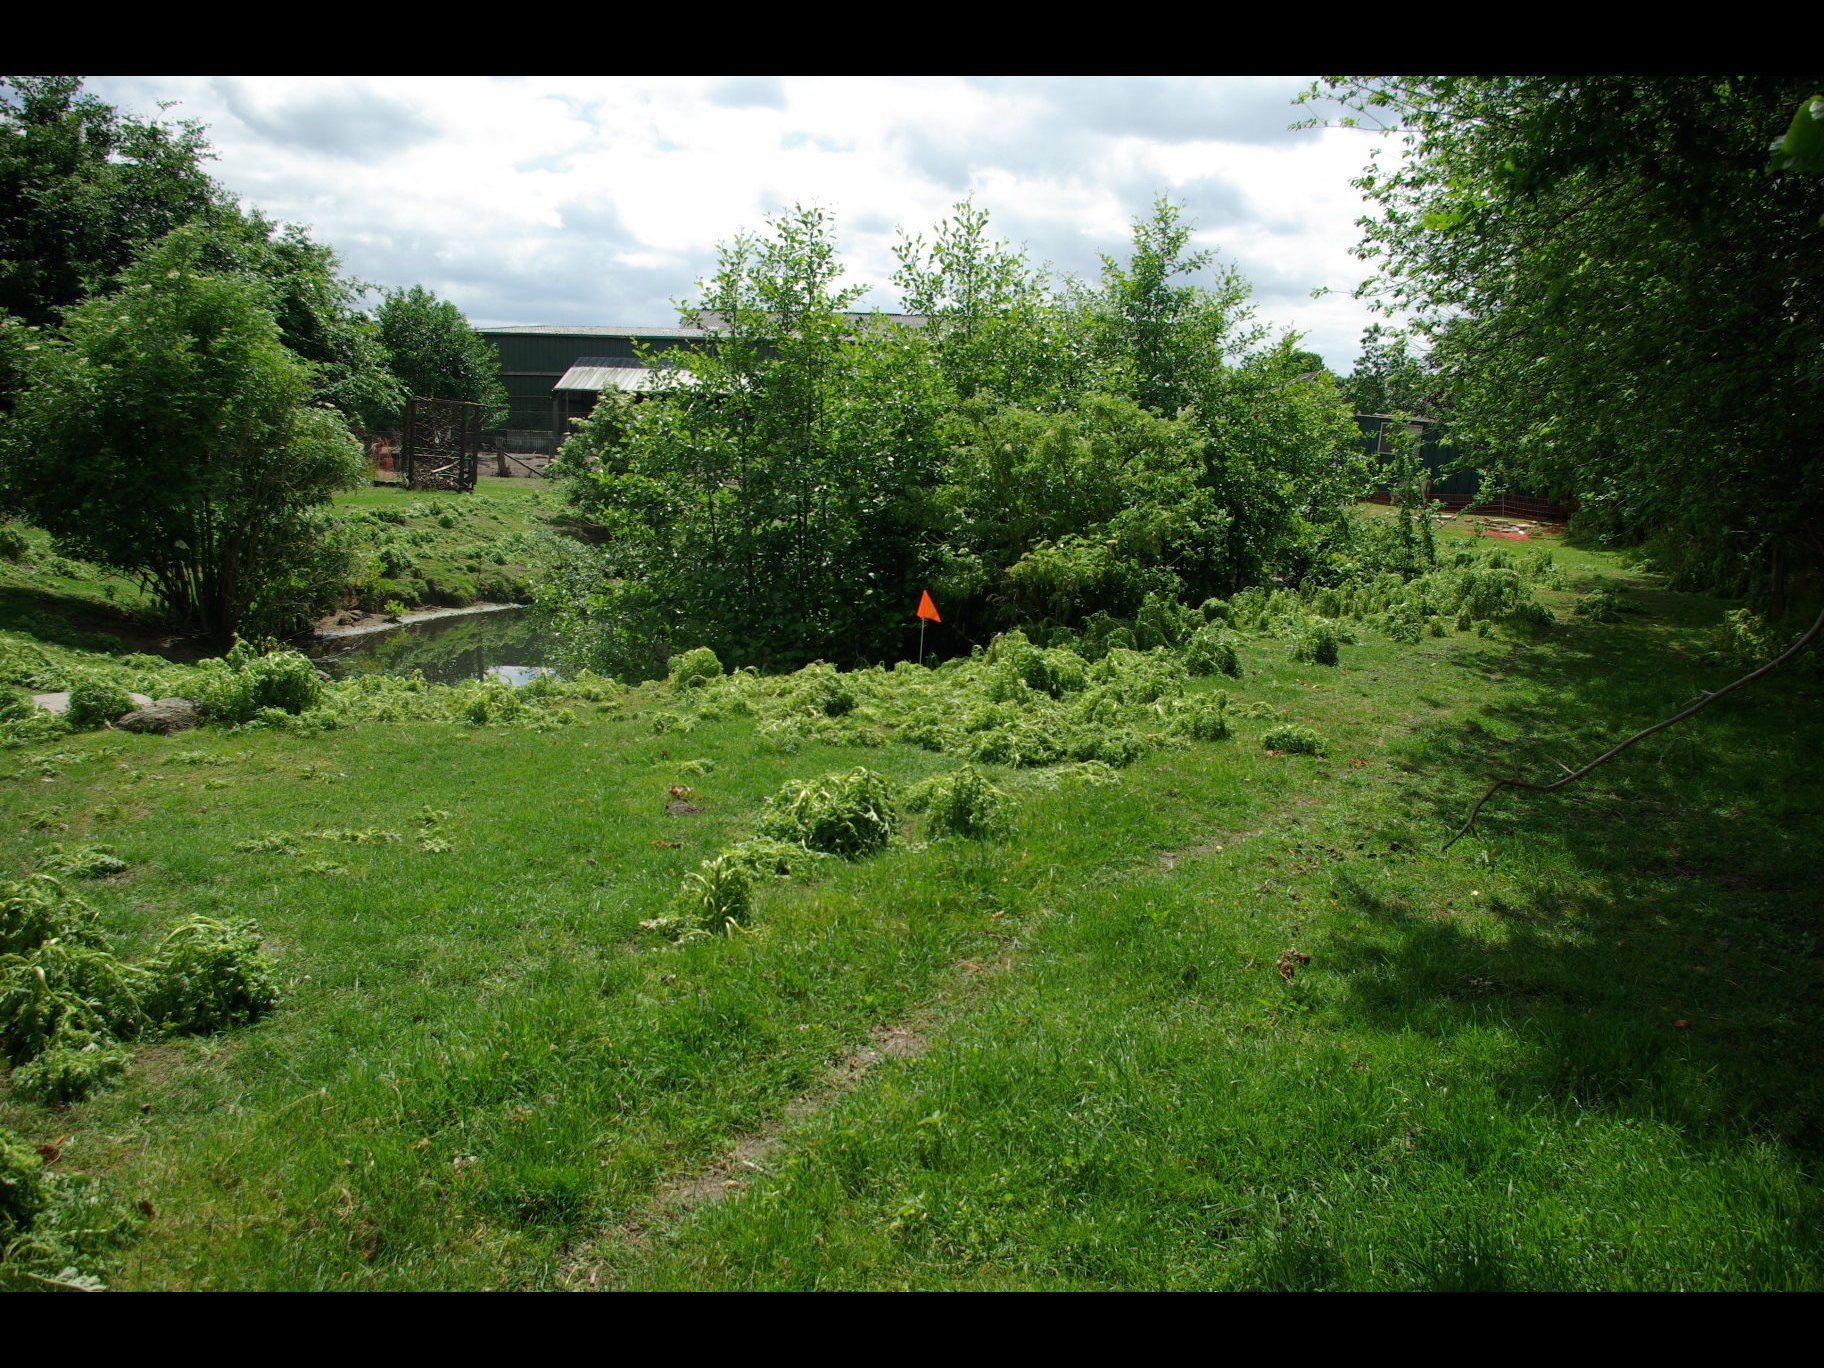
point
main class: Grassland
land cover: Grassland without tree/shrub cover
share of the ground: > 75 %
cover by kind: herbaceous plants 80 %, unconsolidated bare surface 20 %
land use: Agriculture (excluding fallow land and kitchen gardens)
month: June
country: DE
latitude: 54.0848
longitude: 9.8931
